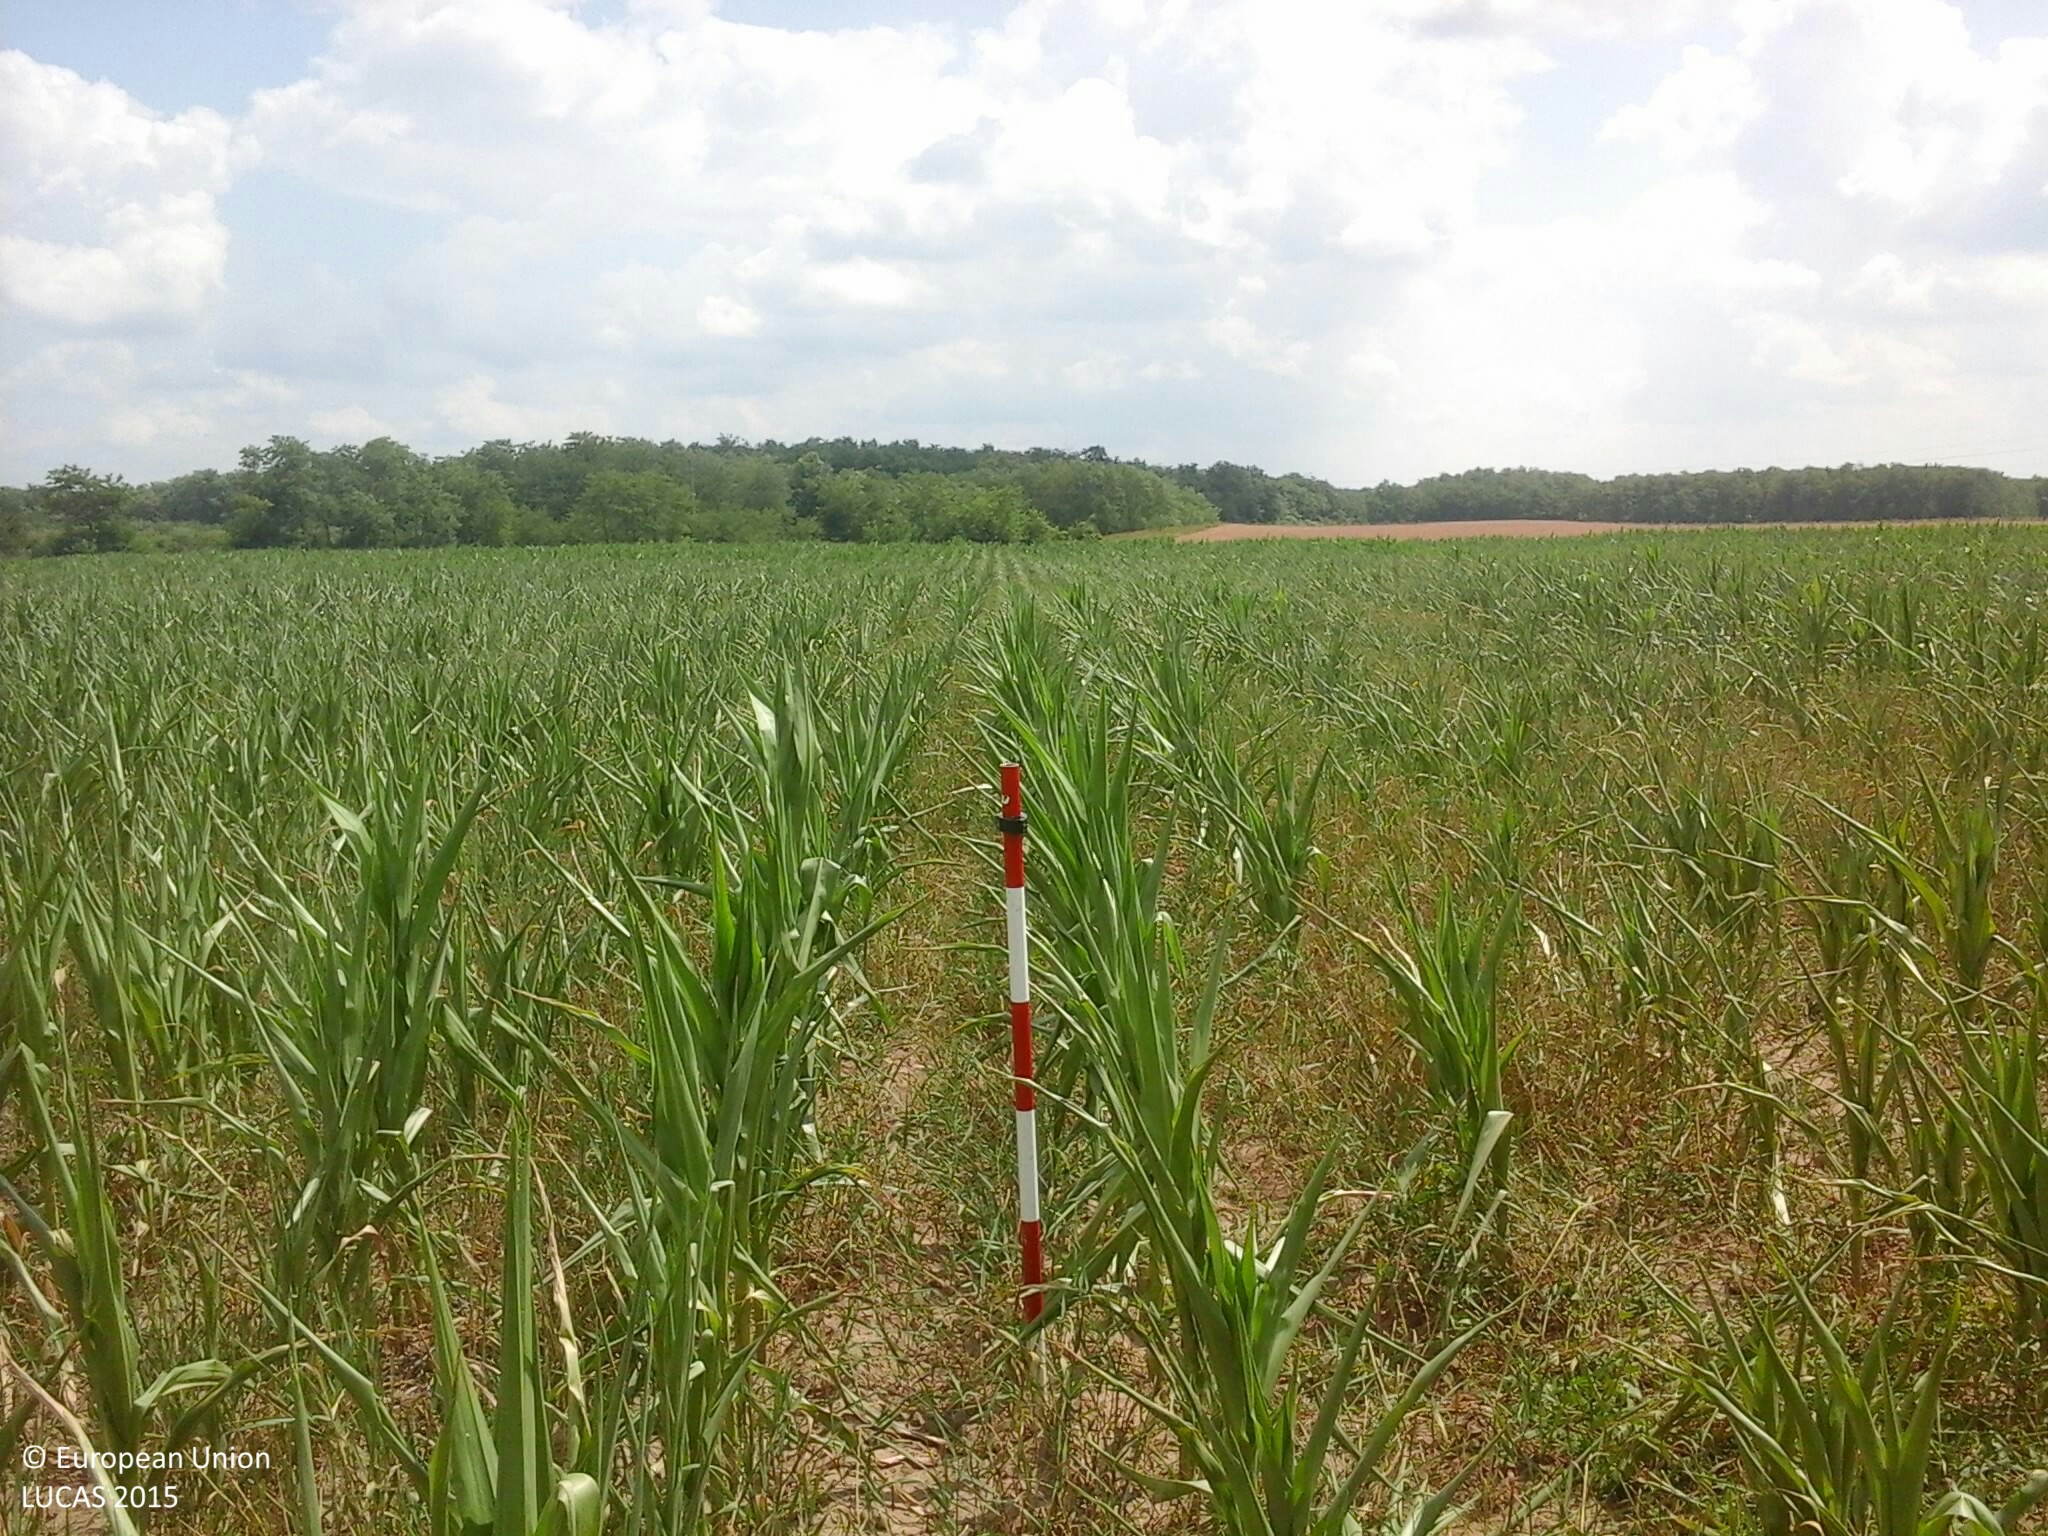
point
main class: Cropland
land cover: Maize
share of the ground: 25 - 50 %
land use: Agriculture (excluding fallow land and kitchen gardens)
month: July
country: HU
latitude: 47.8225
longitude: 22.1413
